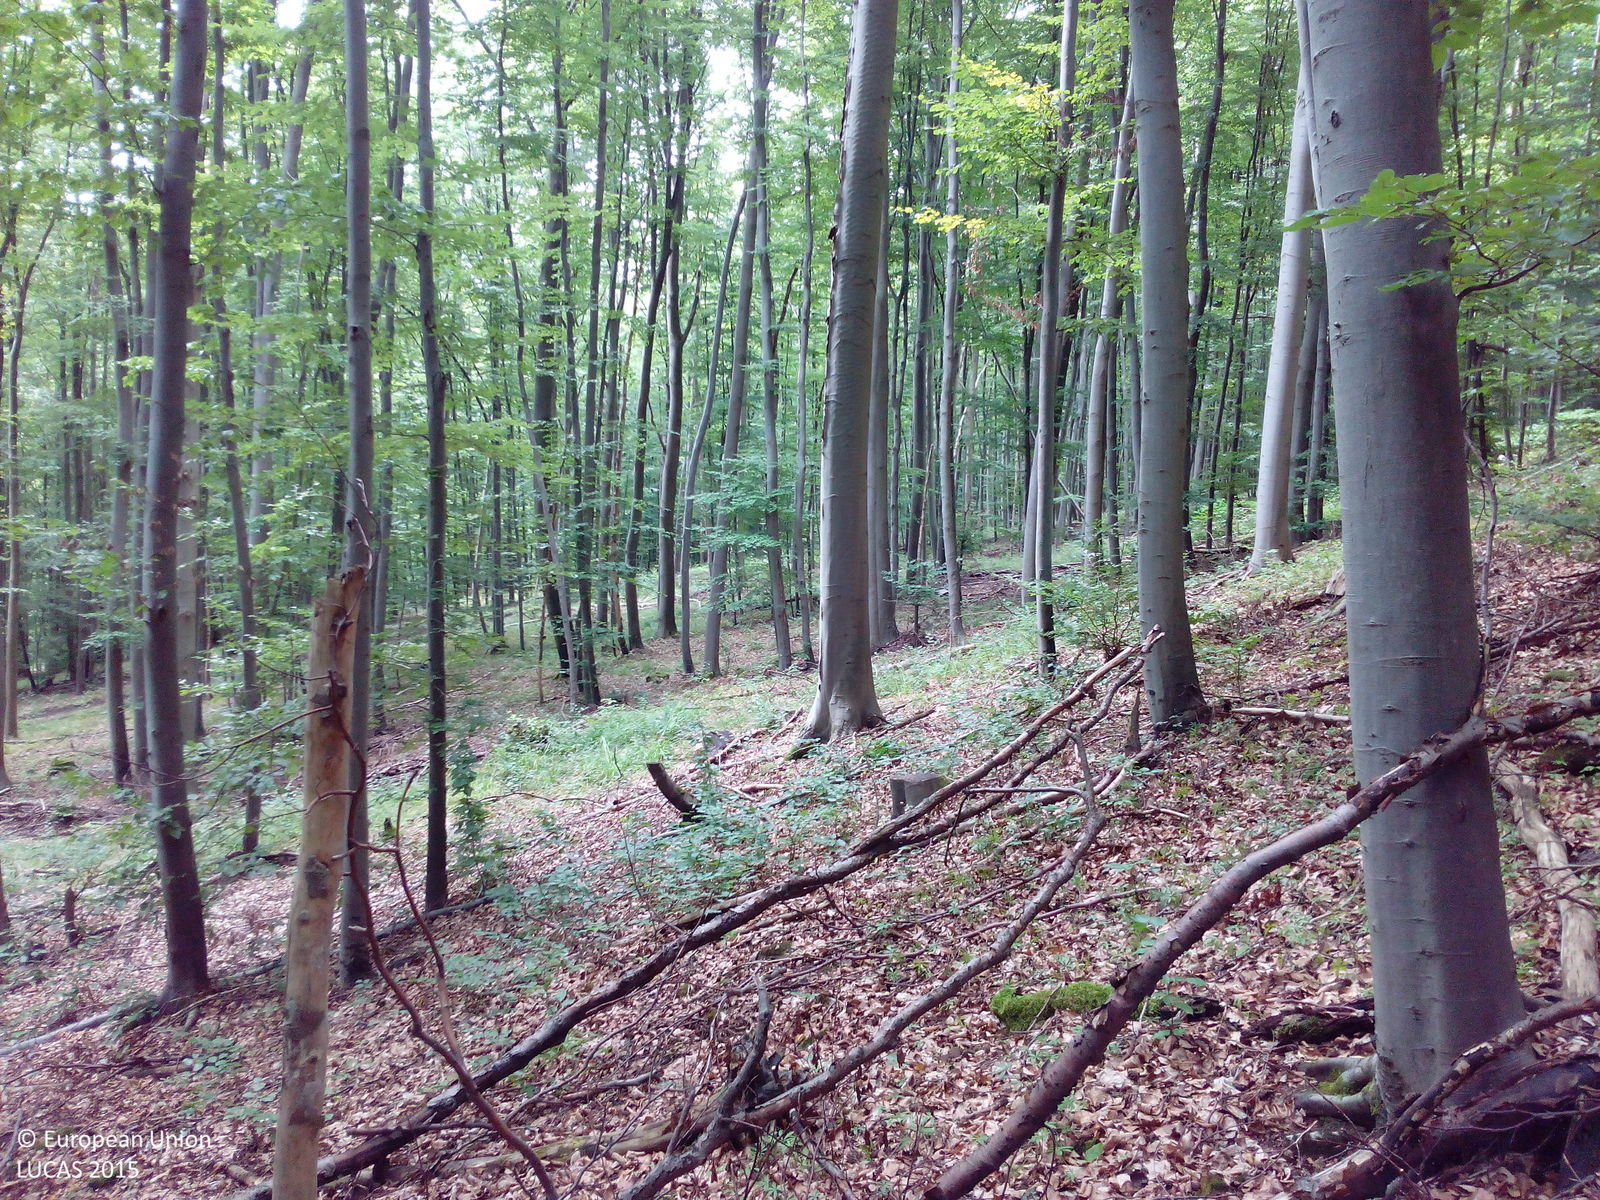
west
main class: Woodland
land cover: Broadleaved woodland
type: beech forest
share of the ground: > 75 %
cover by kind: broadleaved forest trees 100 %
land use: Forestry
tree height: > 5 m
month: August
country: DE
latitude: 51.0829
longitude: 10.2711
